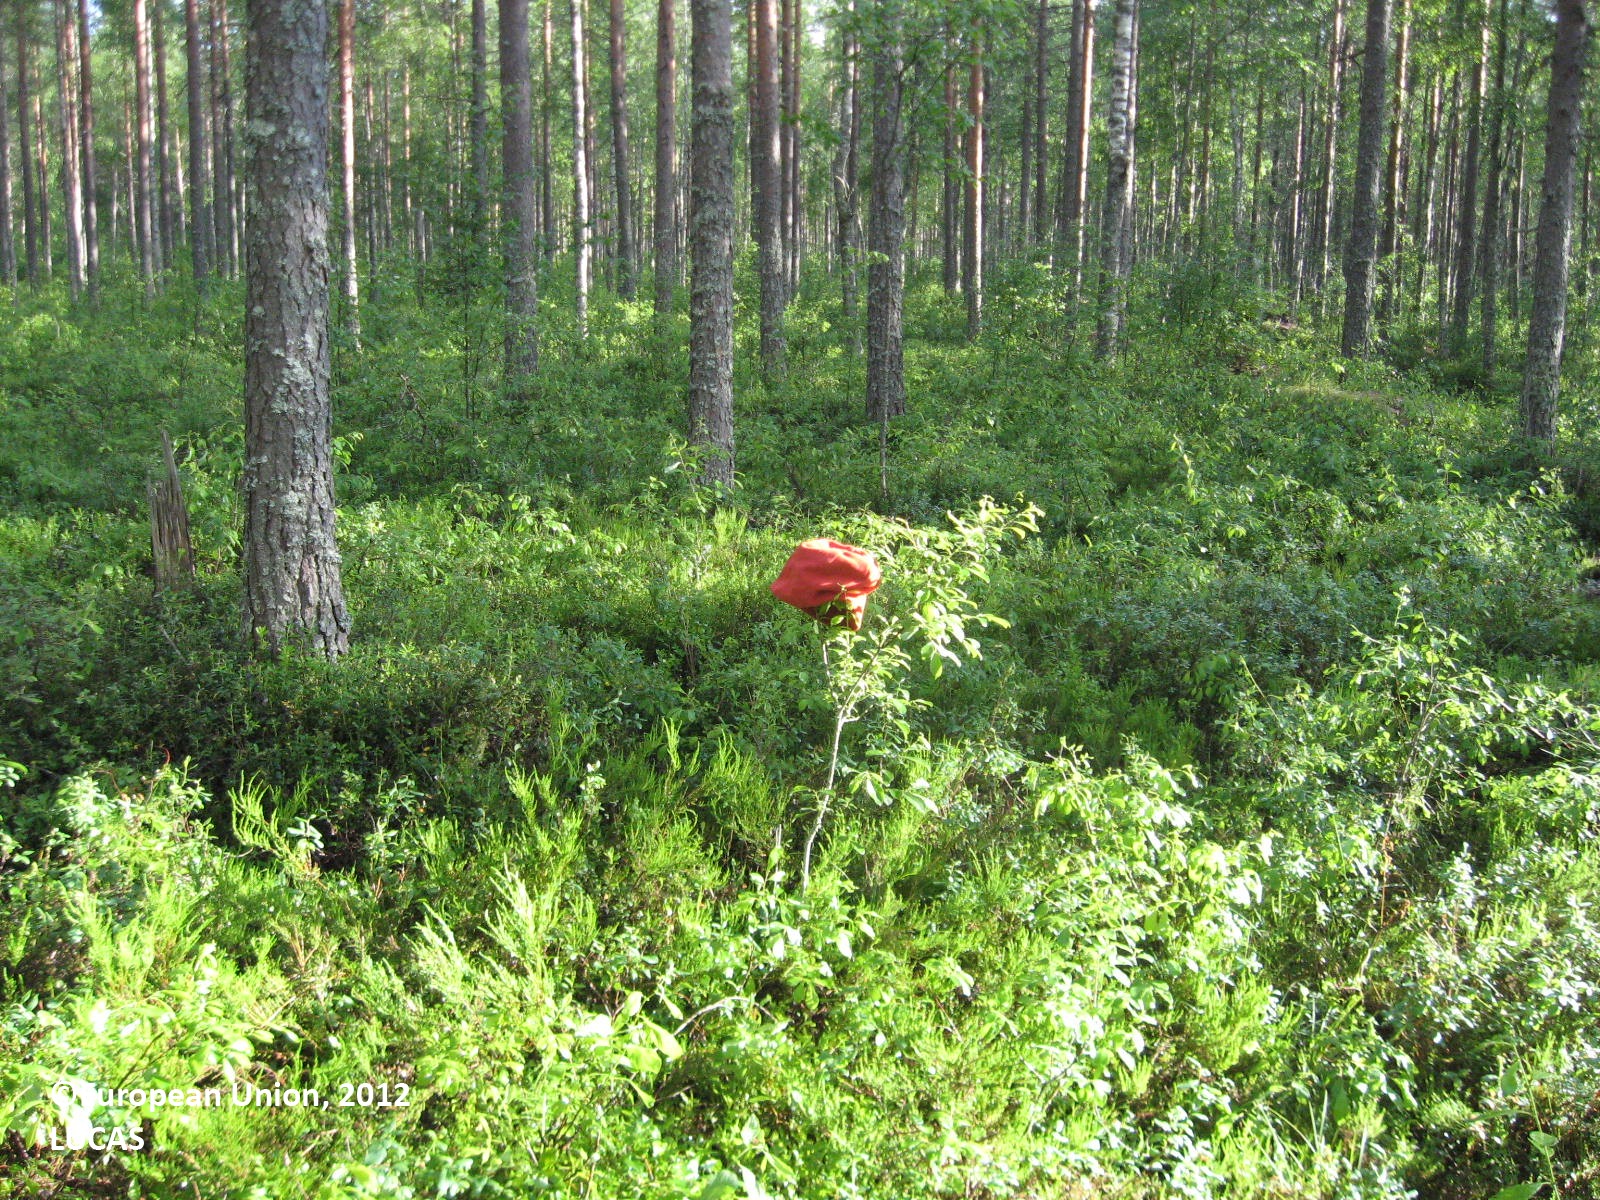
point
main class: Woodland
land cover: Pine dominated mixed woodland
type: boreal forest
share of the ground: > 75 %
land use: Forestry
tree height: > 5 m
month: July
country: FI
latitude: 62.2702
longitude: 22.5220
